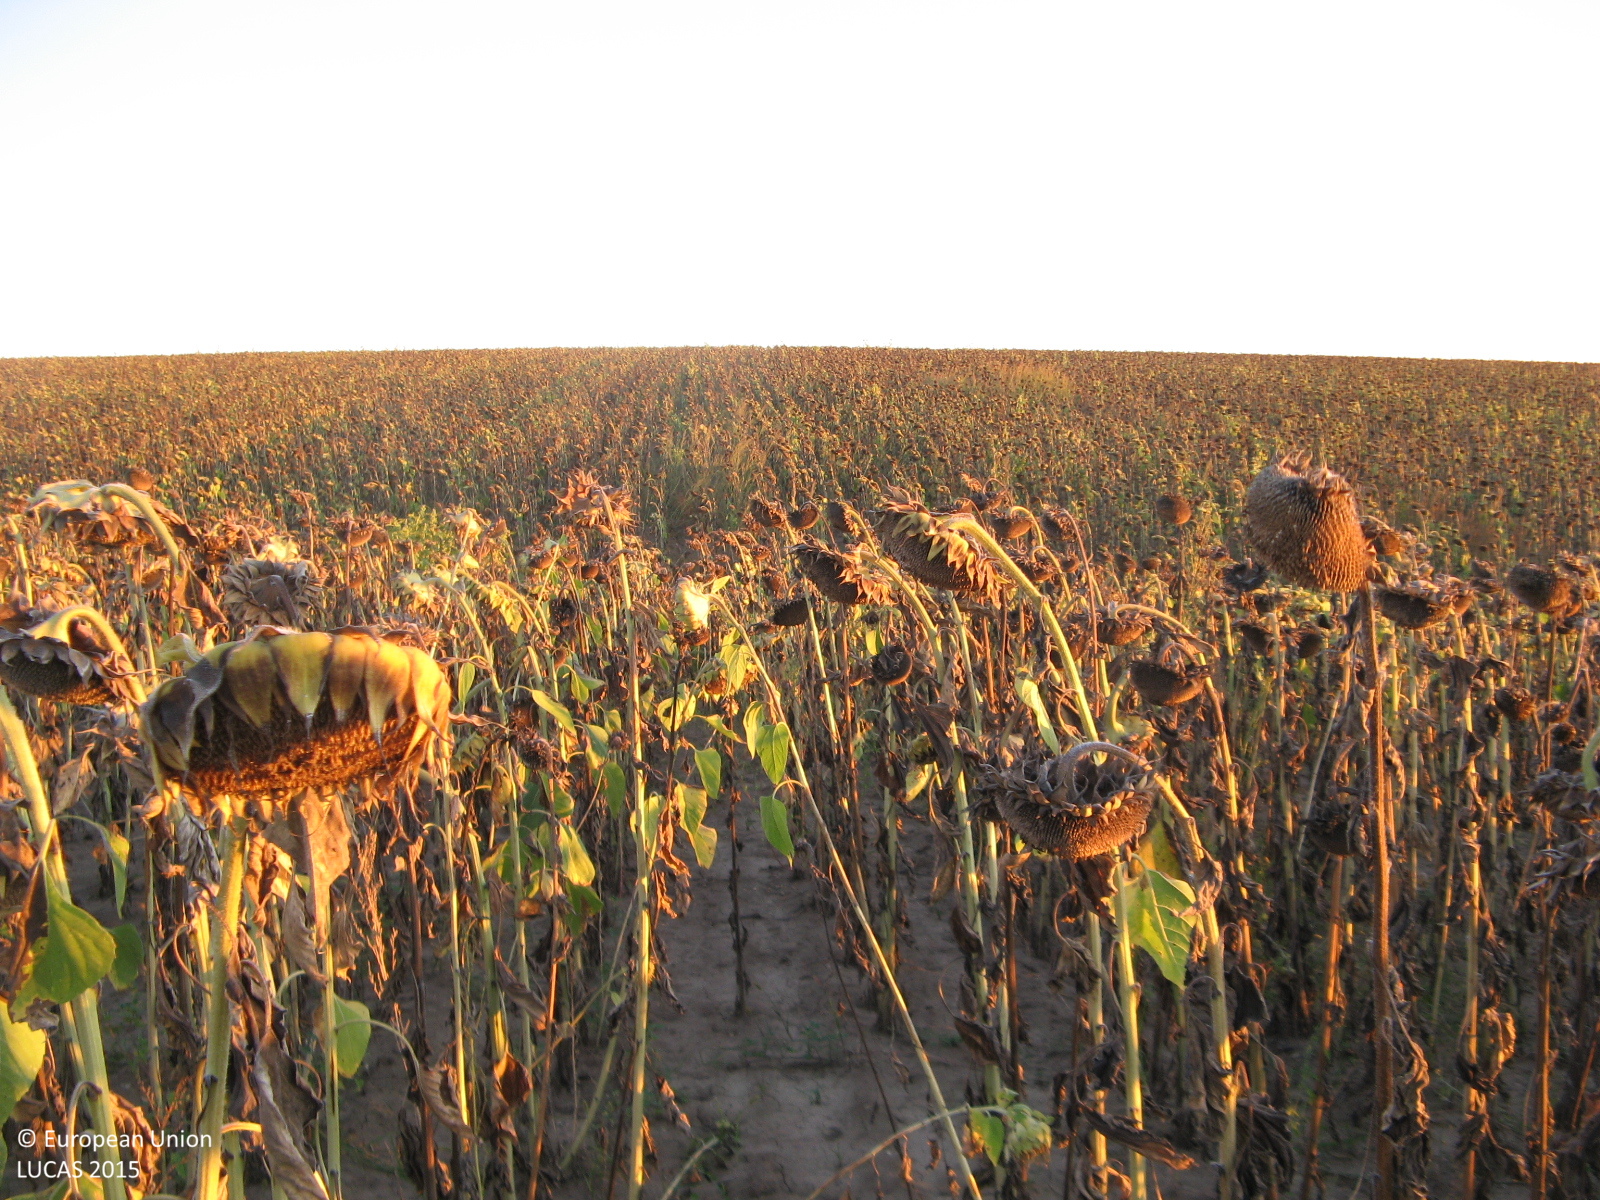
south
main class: Cropland
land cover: Sunflower
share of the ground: > 75 %
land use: Agriculture (excluding fallow land and kitchen gardens)
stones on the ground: < 10 %
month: September
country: BG
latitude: 43.5681
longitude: 26.0543
